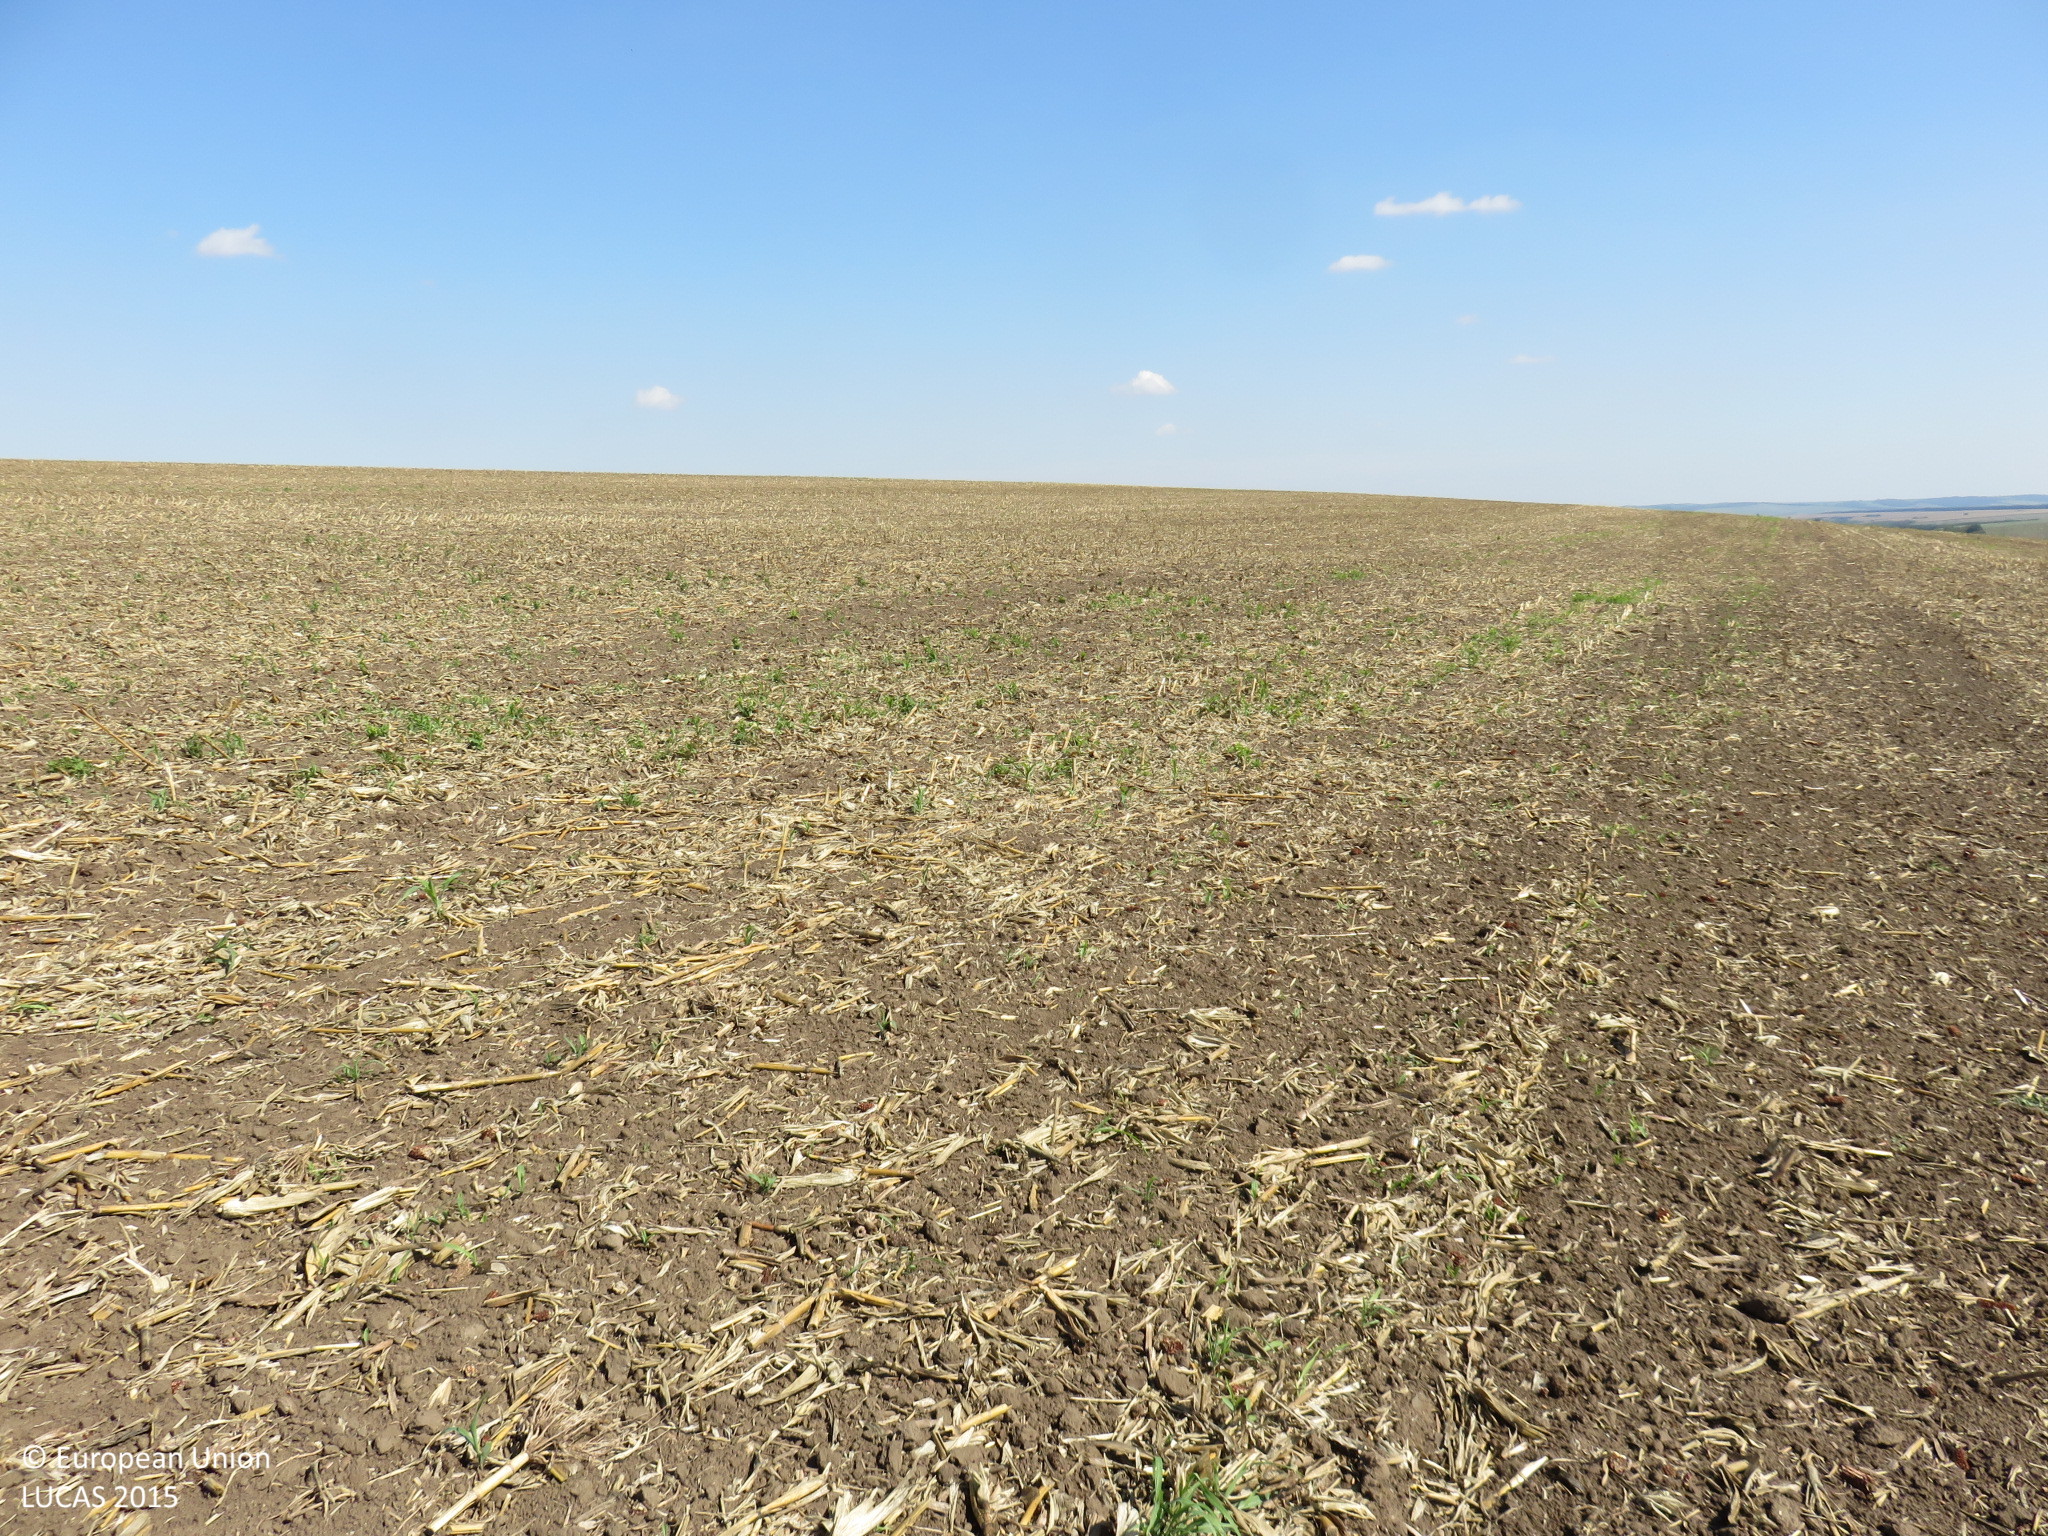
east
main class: Cropland
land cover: Maize
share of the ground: > 75 %
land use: Agriculture (excluding fallow land and kitchen gardens)
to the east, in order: Maize
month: September
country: BG
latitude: 43.6187
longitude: 24.4992
